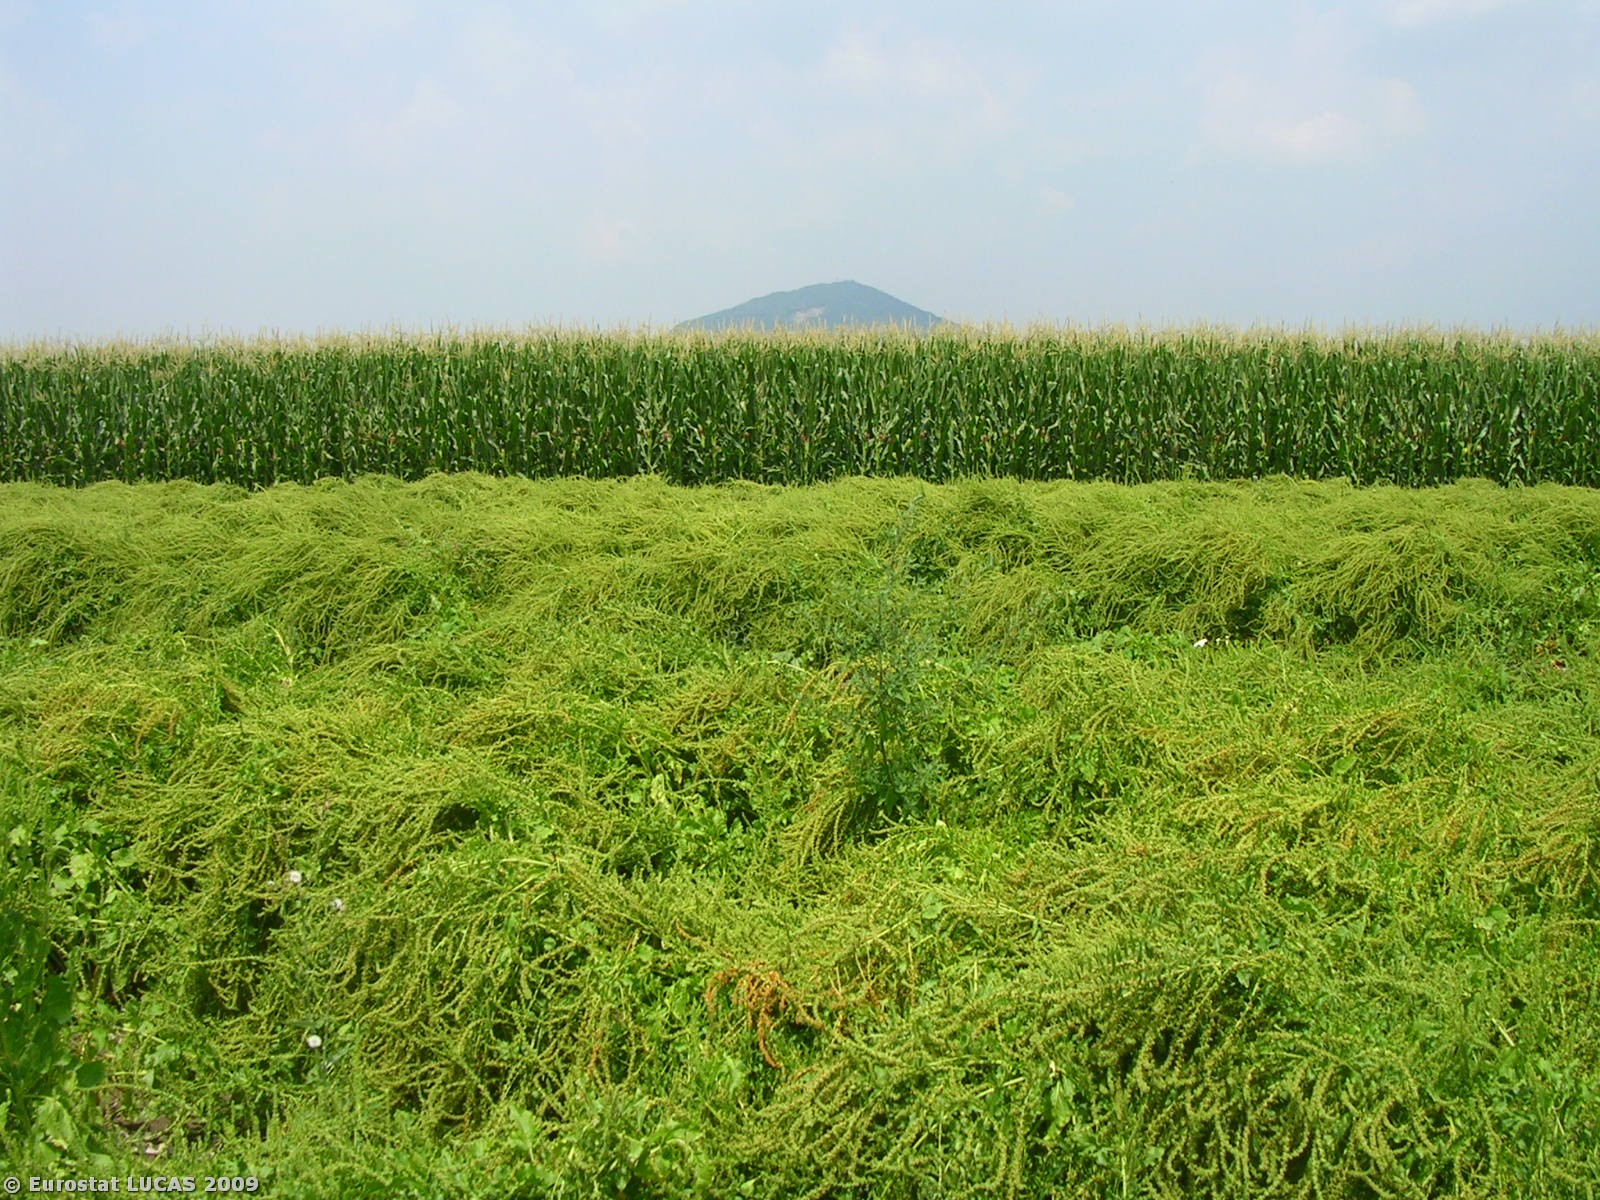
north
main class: Cropland
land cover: Sugar beet
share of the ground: 50 - 75 %
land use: Agriculture (excluding fallow land and kitchen gardens)
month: July
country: IT
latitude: 45.2573
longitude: 11.6410
